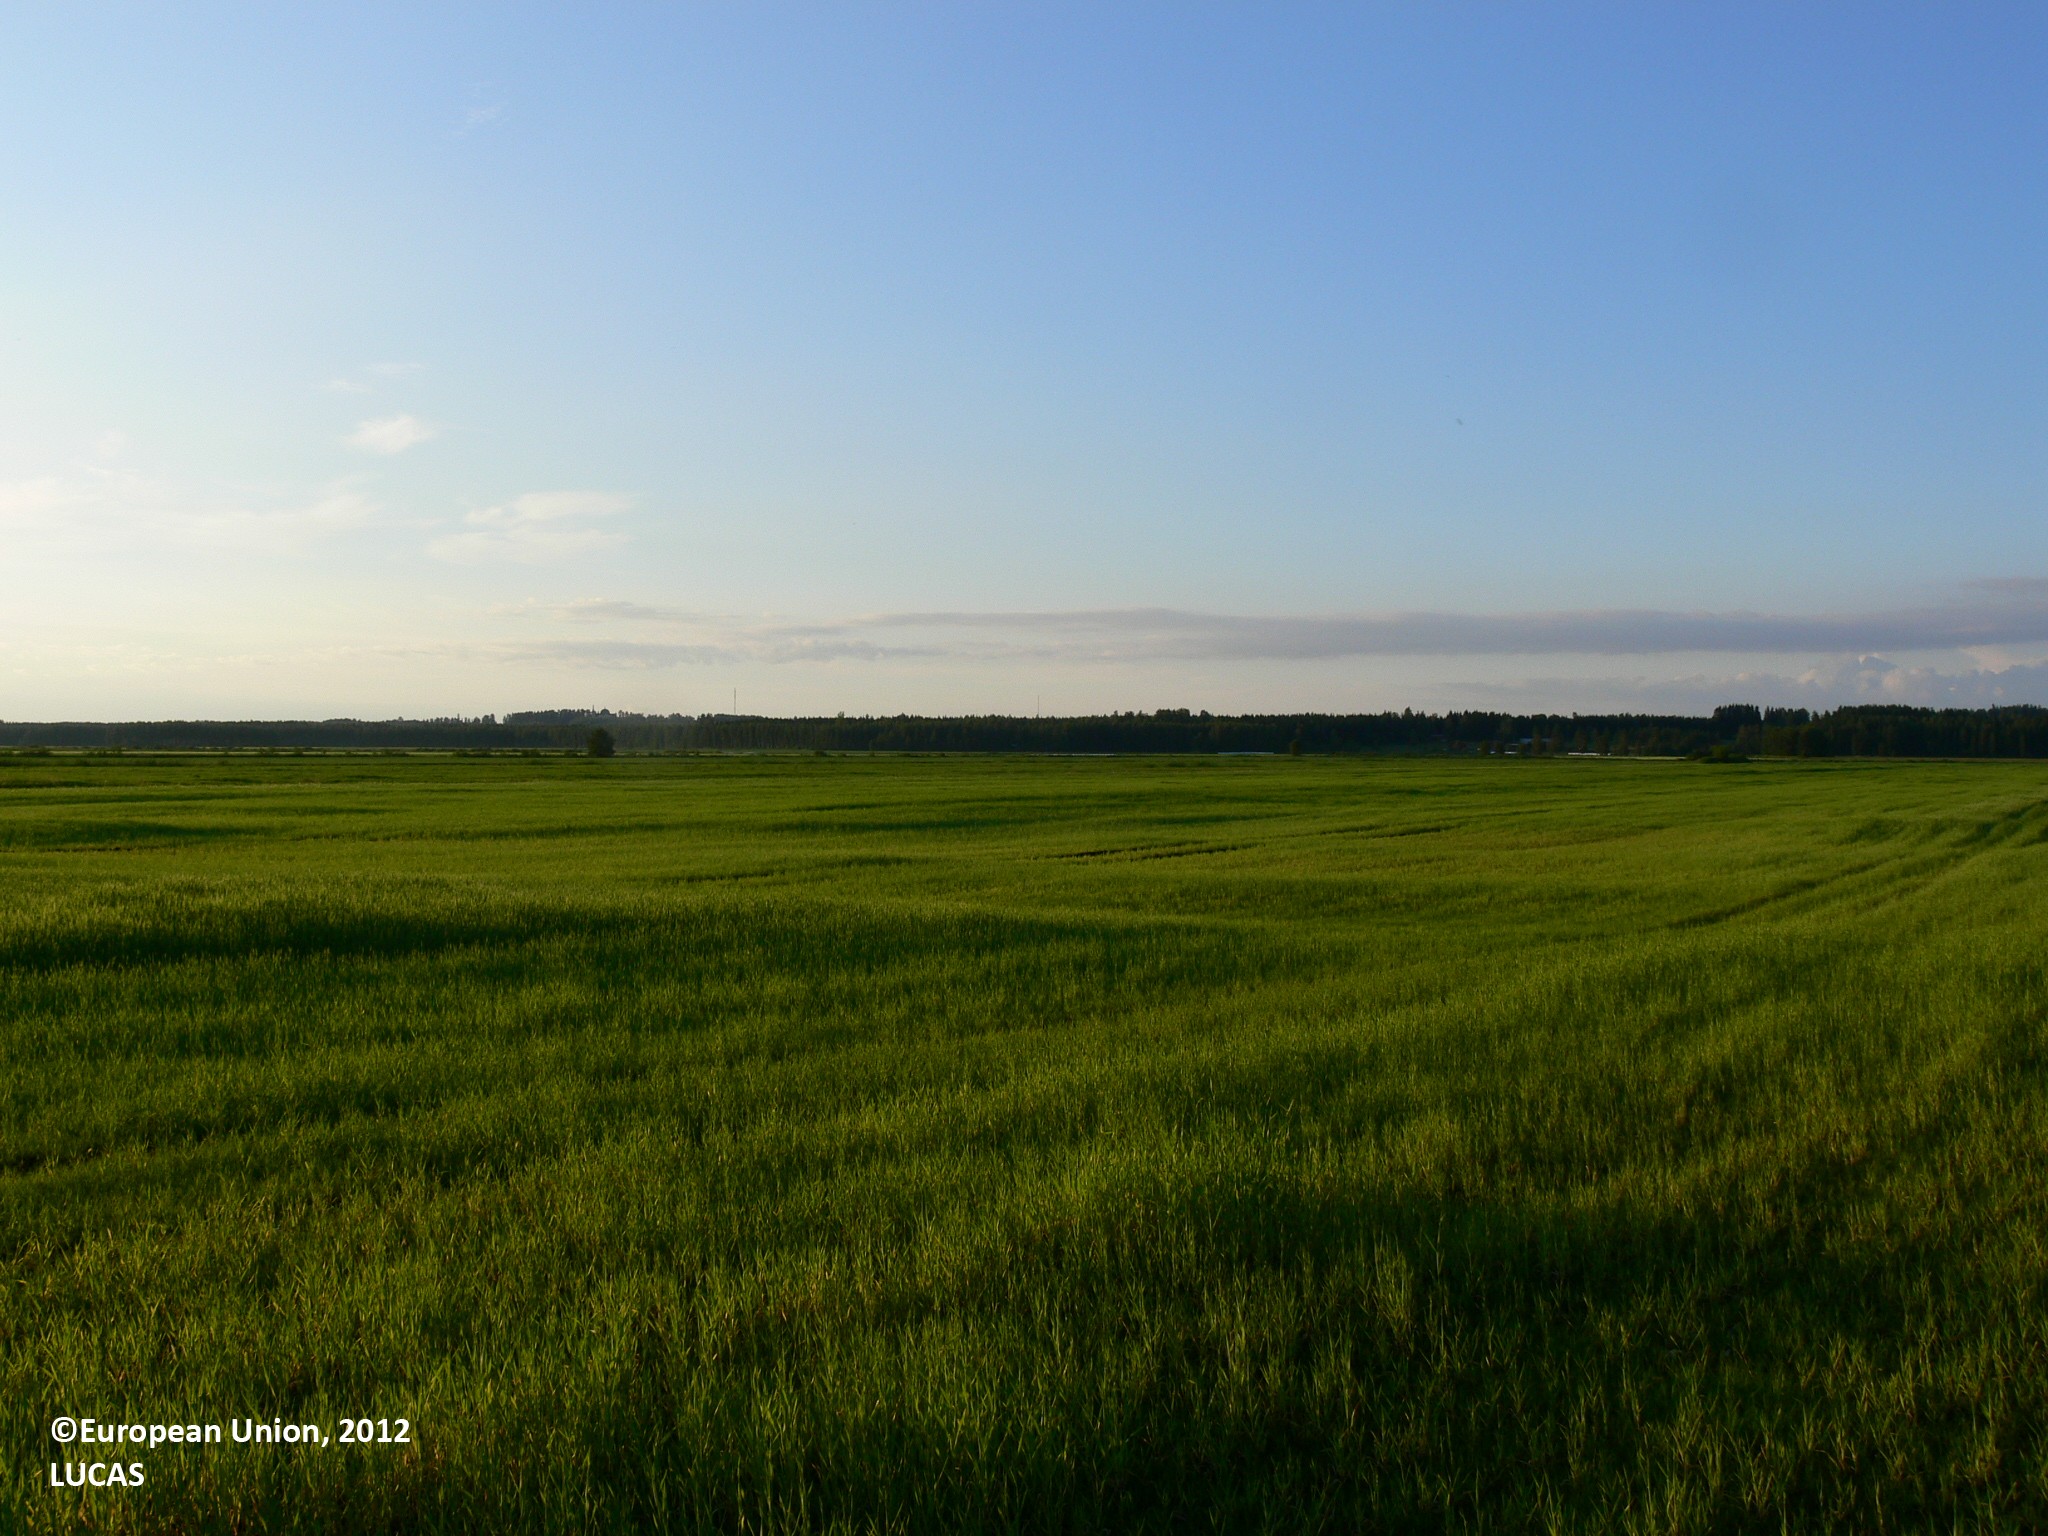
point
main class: Cropland
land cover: Barley
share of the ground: > 75 %
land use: Agriculture (excluding fallow land and kitchen gardens)
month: July
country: FI
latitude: 62.2902
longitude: 29.6207
